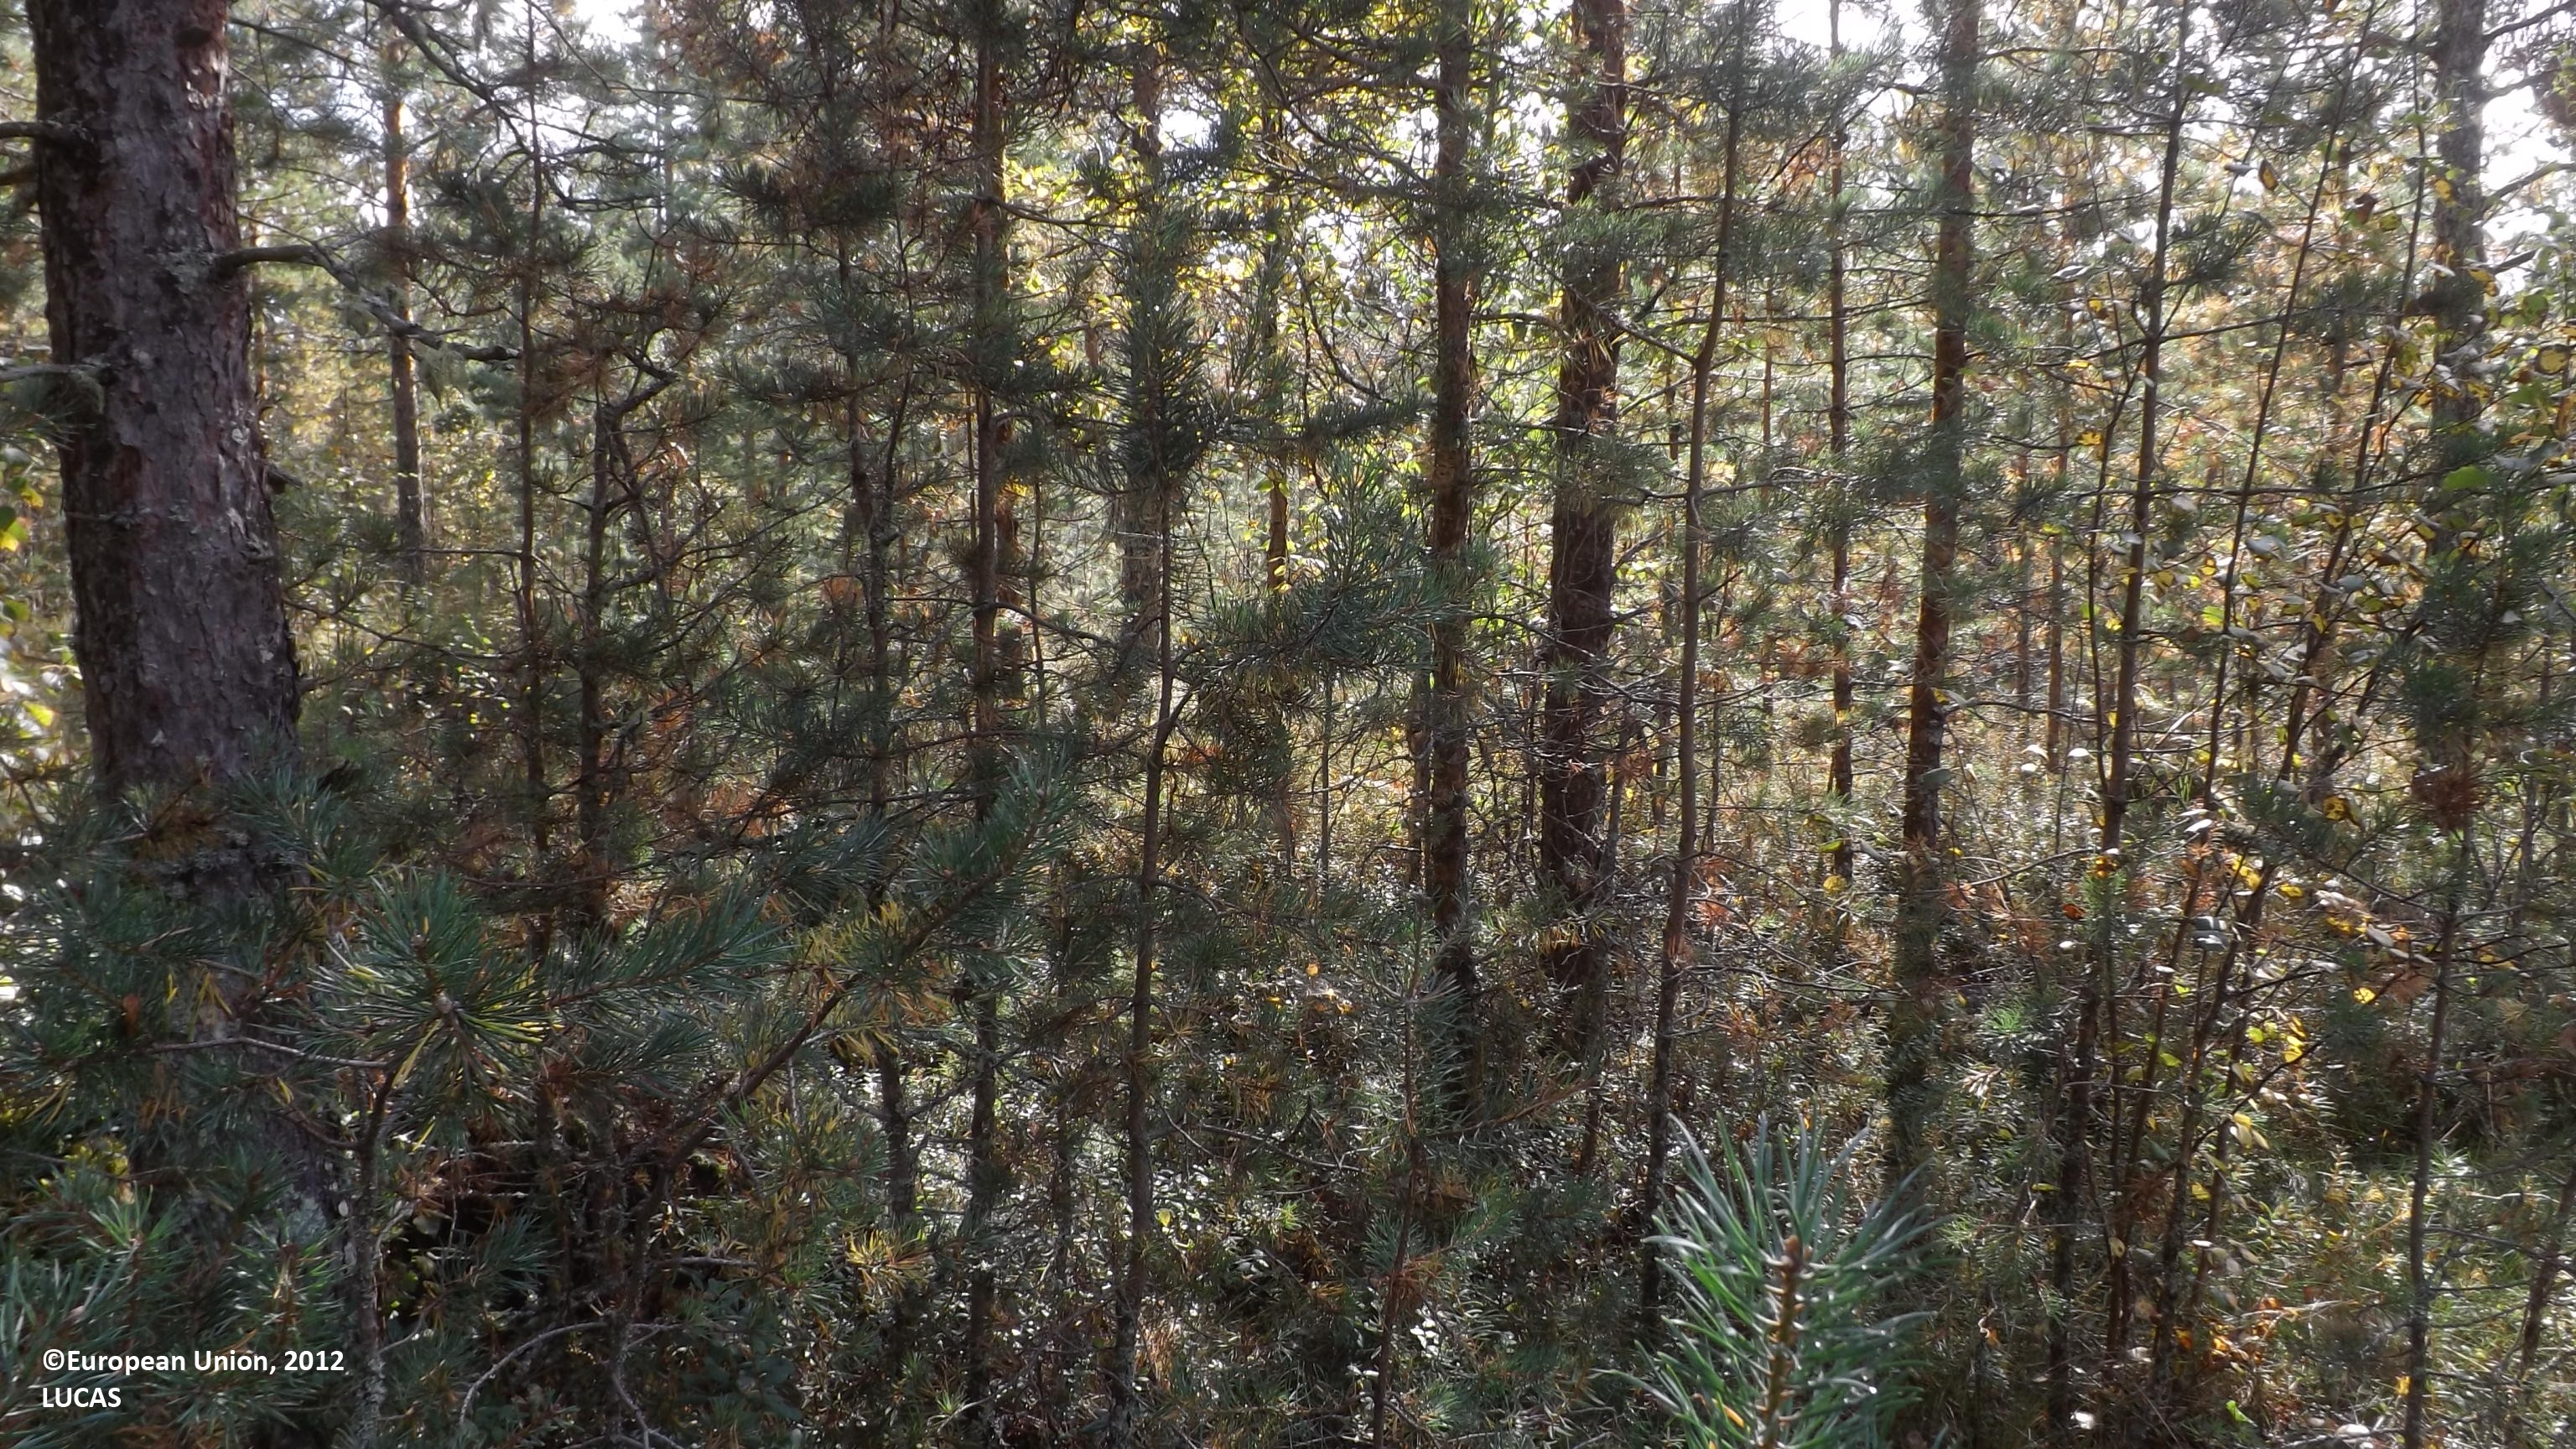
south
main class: Woodland
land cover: Pine dominated coniferous woodland
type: mire and swamp forests
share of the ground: 50 - 75 %
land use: Forestry
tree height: < 5 m
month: August
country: FI
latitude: 63.8935
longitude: 23.6876
